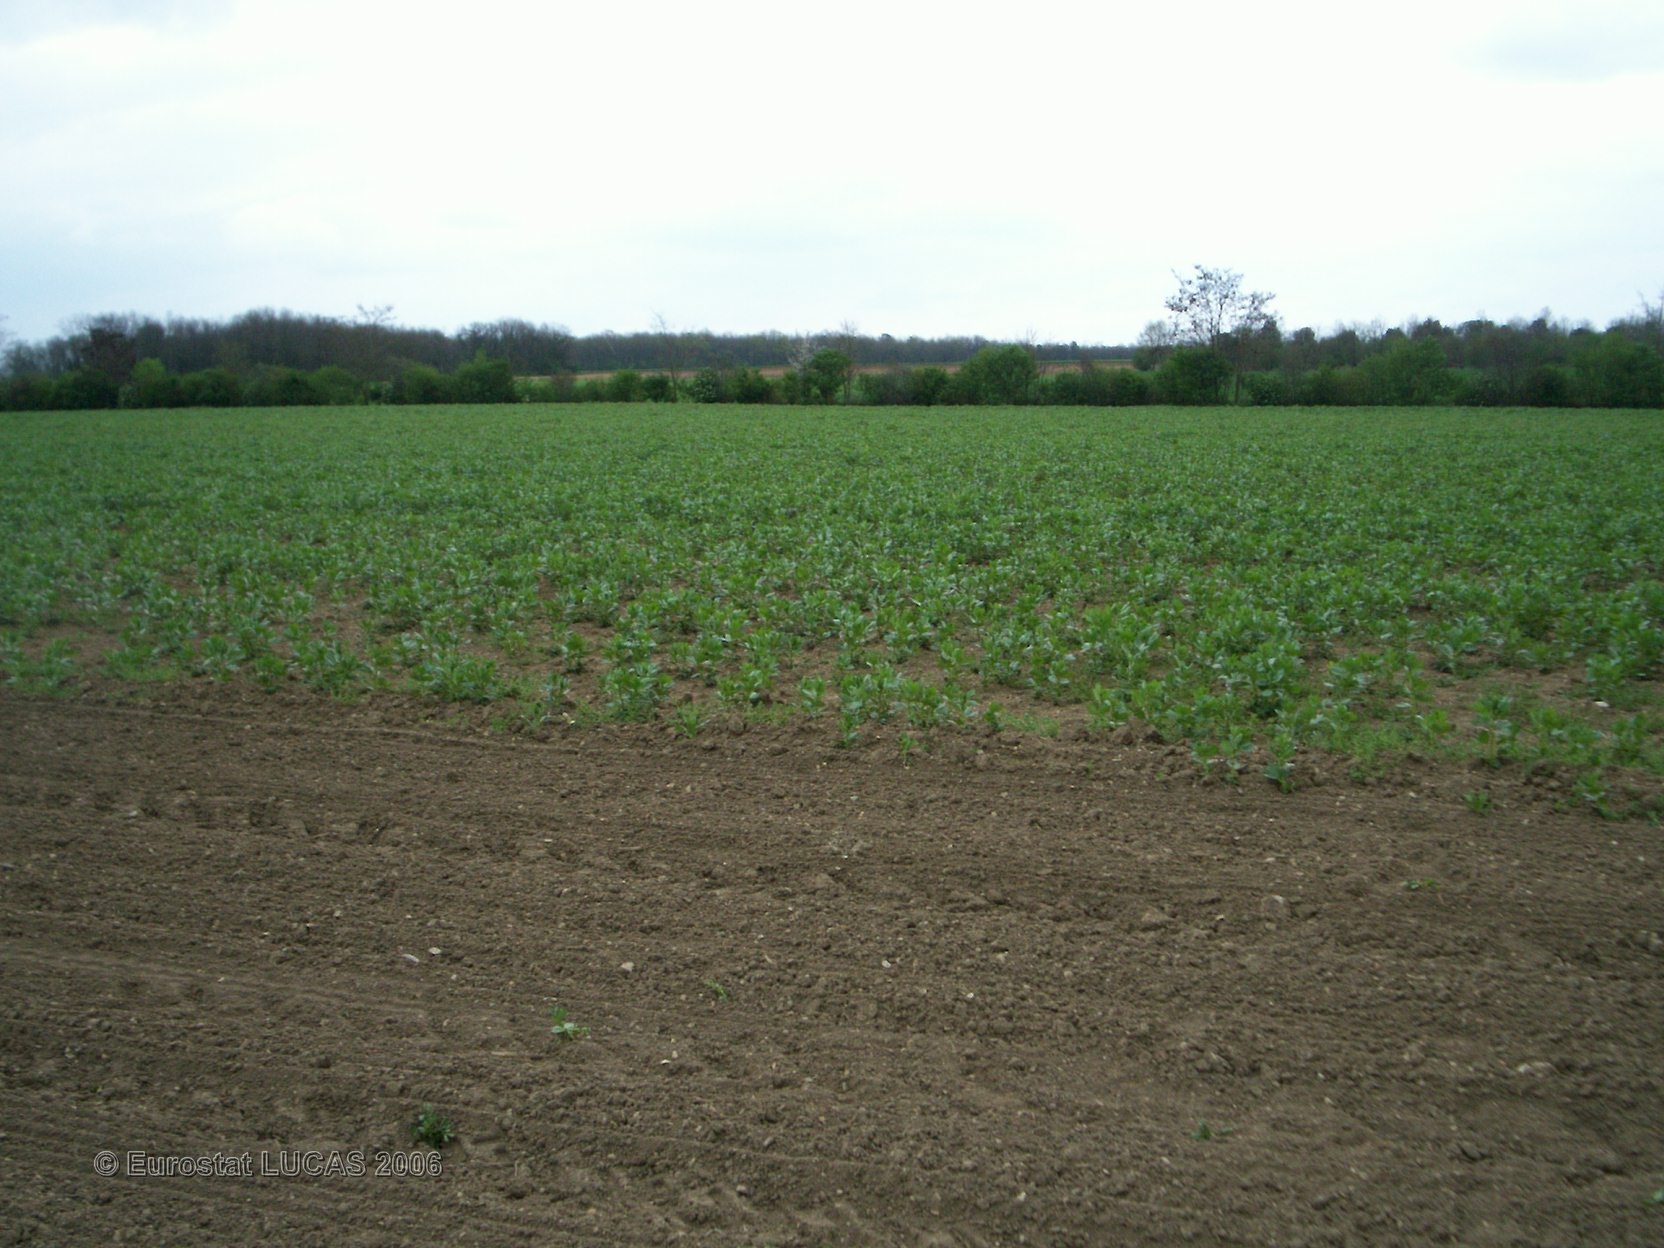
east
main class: Cropland
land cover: Maize
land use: Agriculture (excluding fallow land and kitchen gardens)
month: June
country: FR
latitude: 47.0342
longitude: 0.3065
